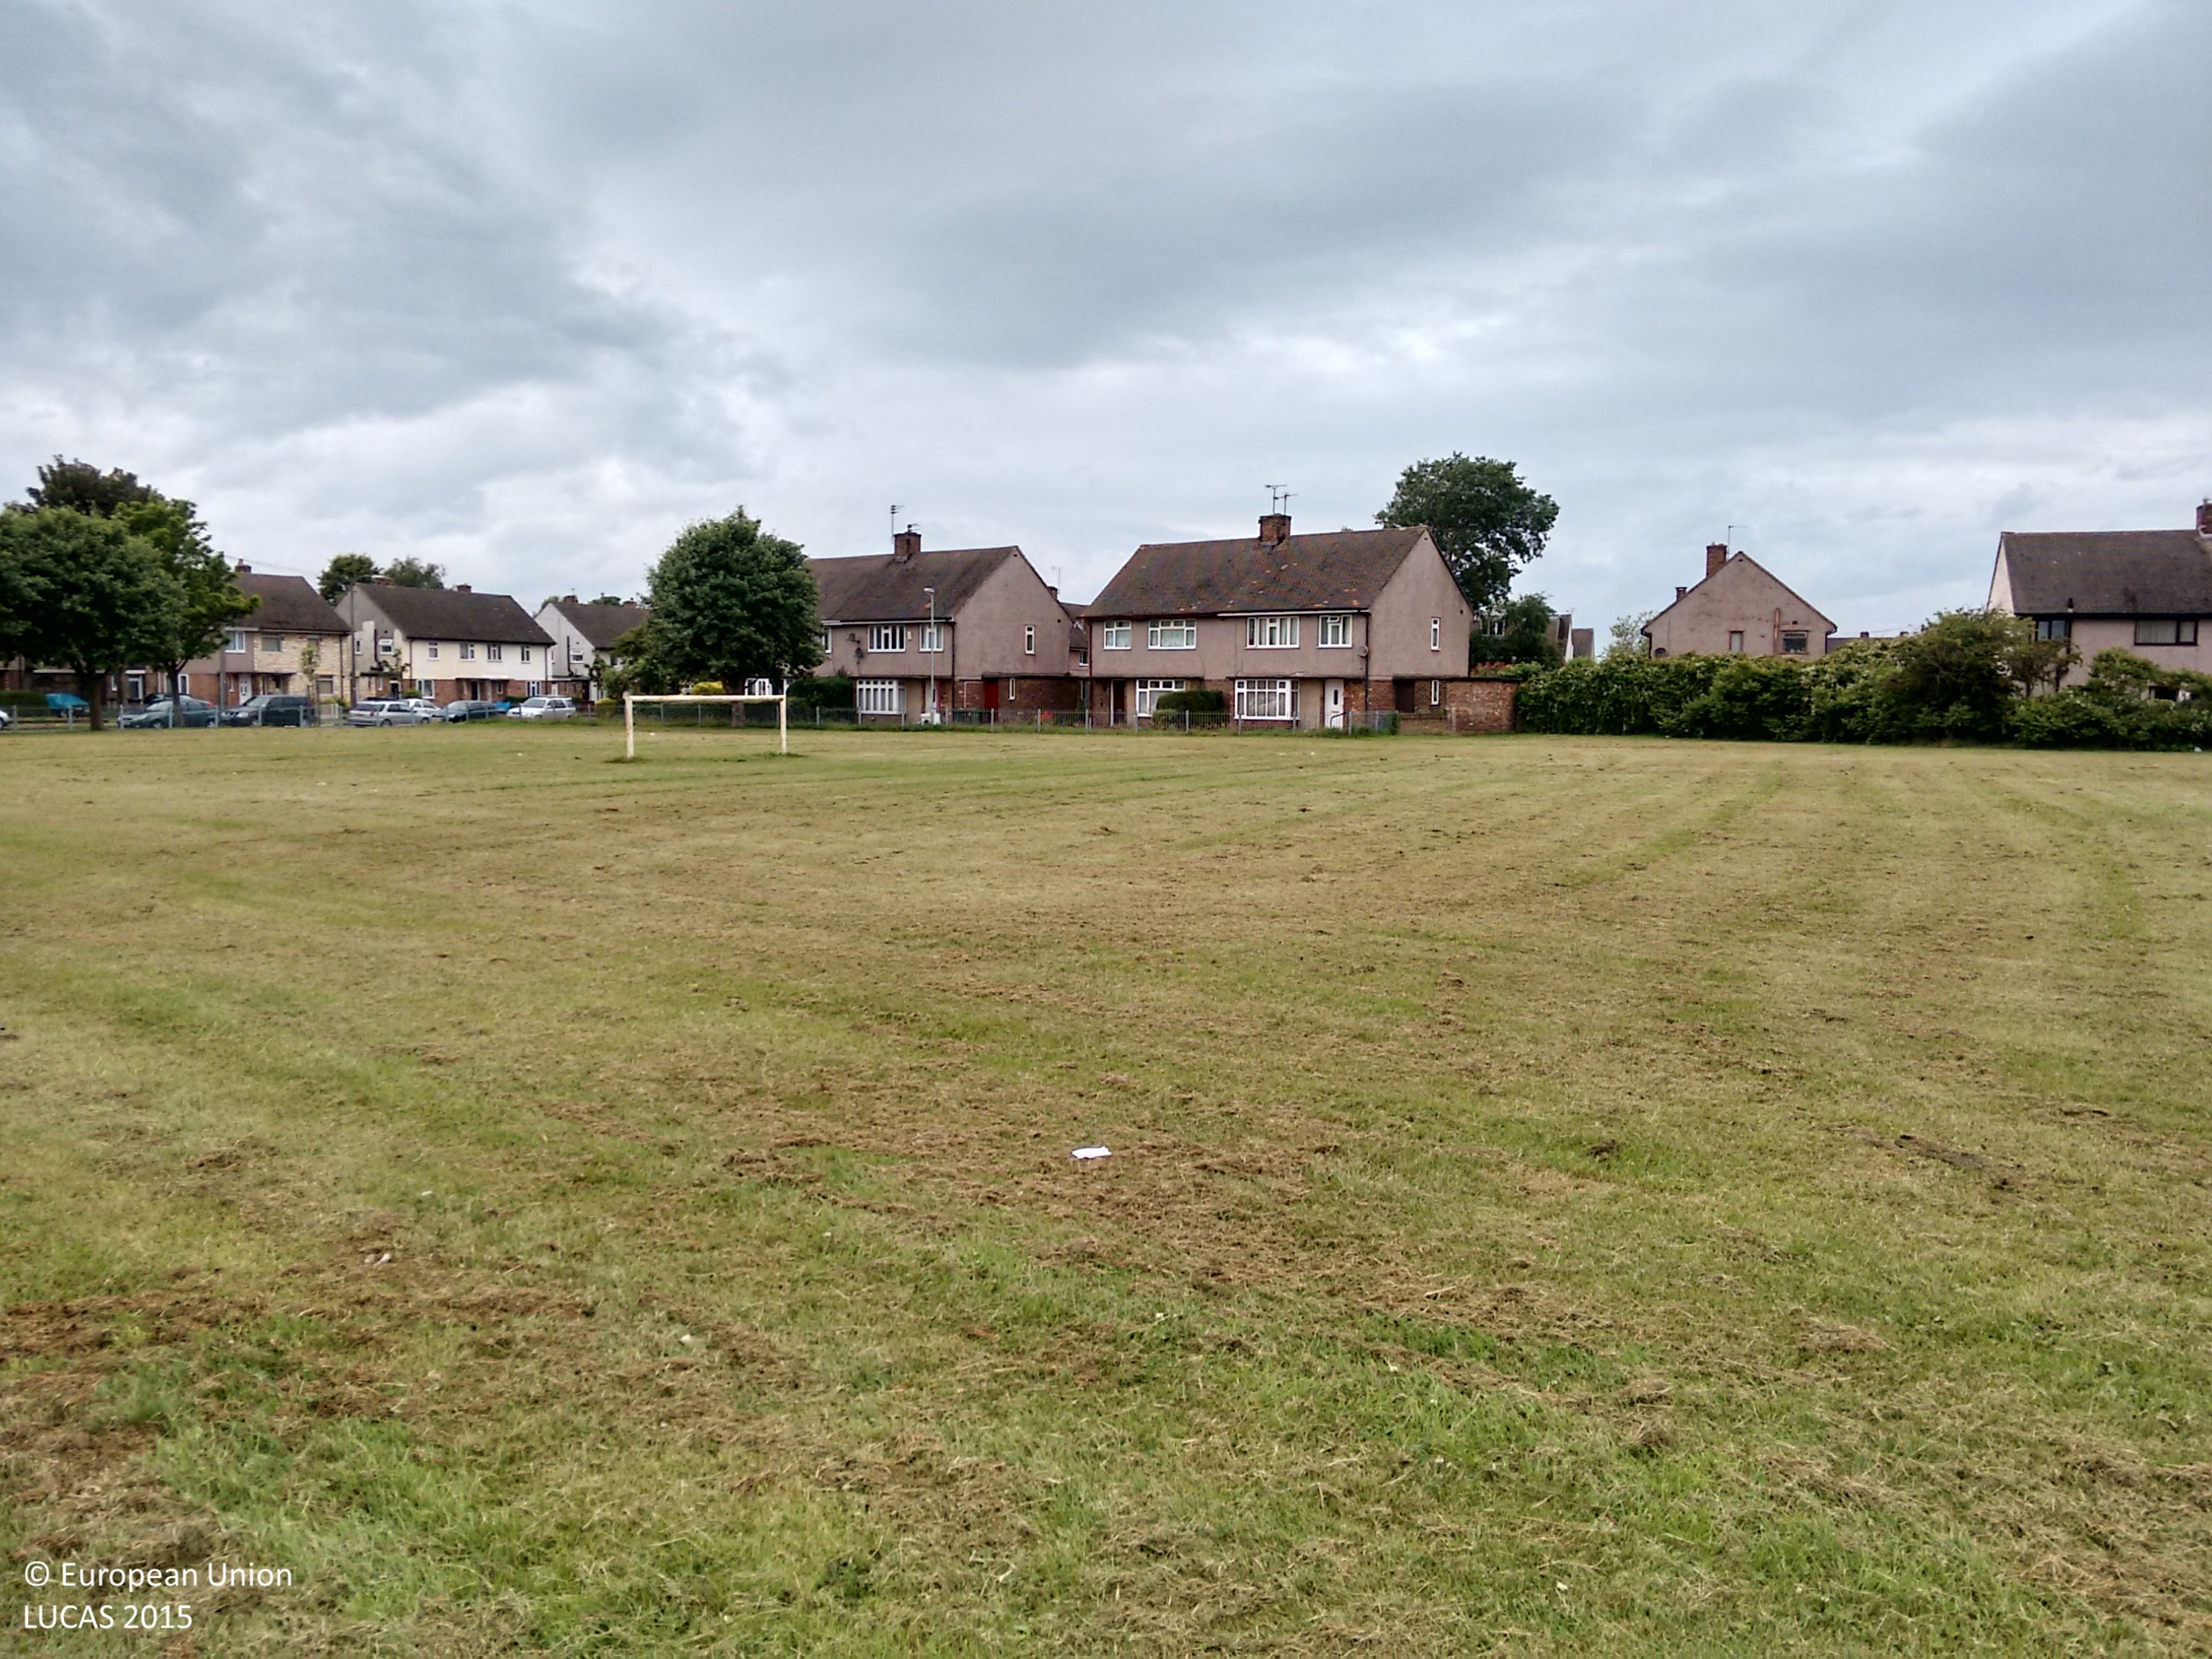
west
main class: Grassland
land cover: Grassland without tree/shrub cover
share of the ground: > 75 %
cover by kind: herbaceous plants 100 %
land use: Amenities, museums, leisure
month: June
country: GB
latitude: 53.4966
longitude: -3.0234
